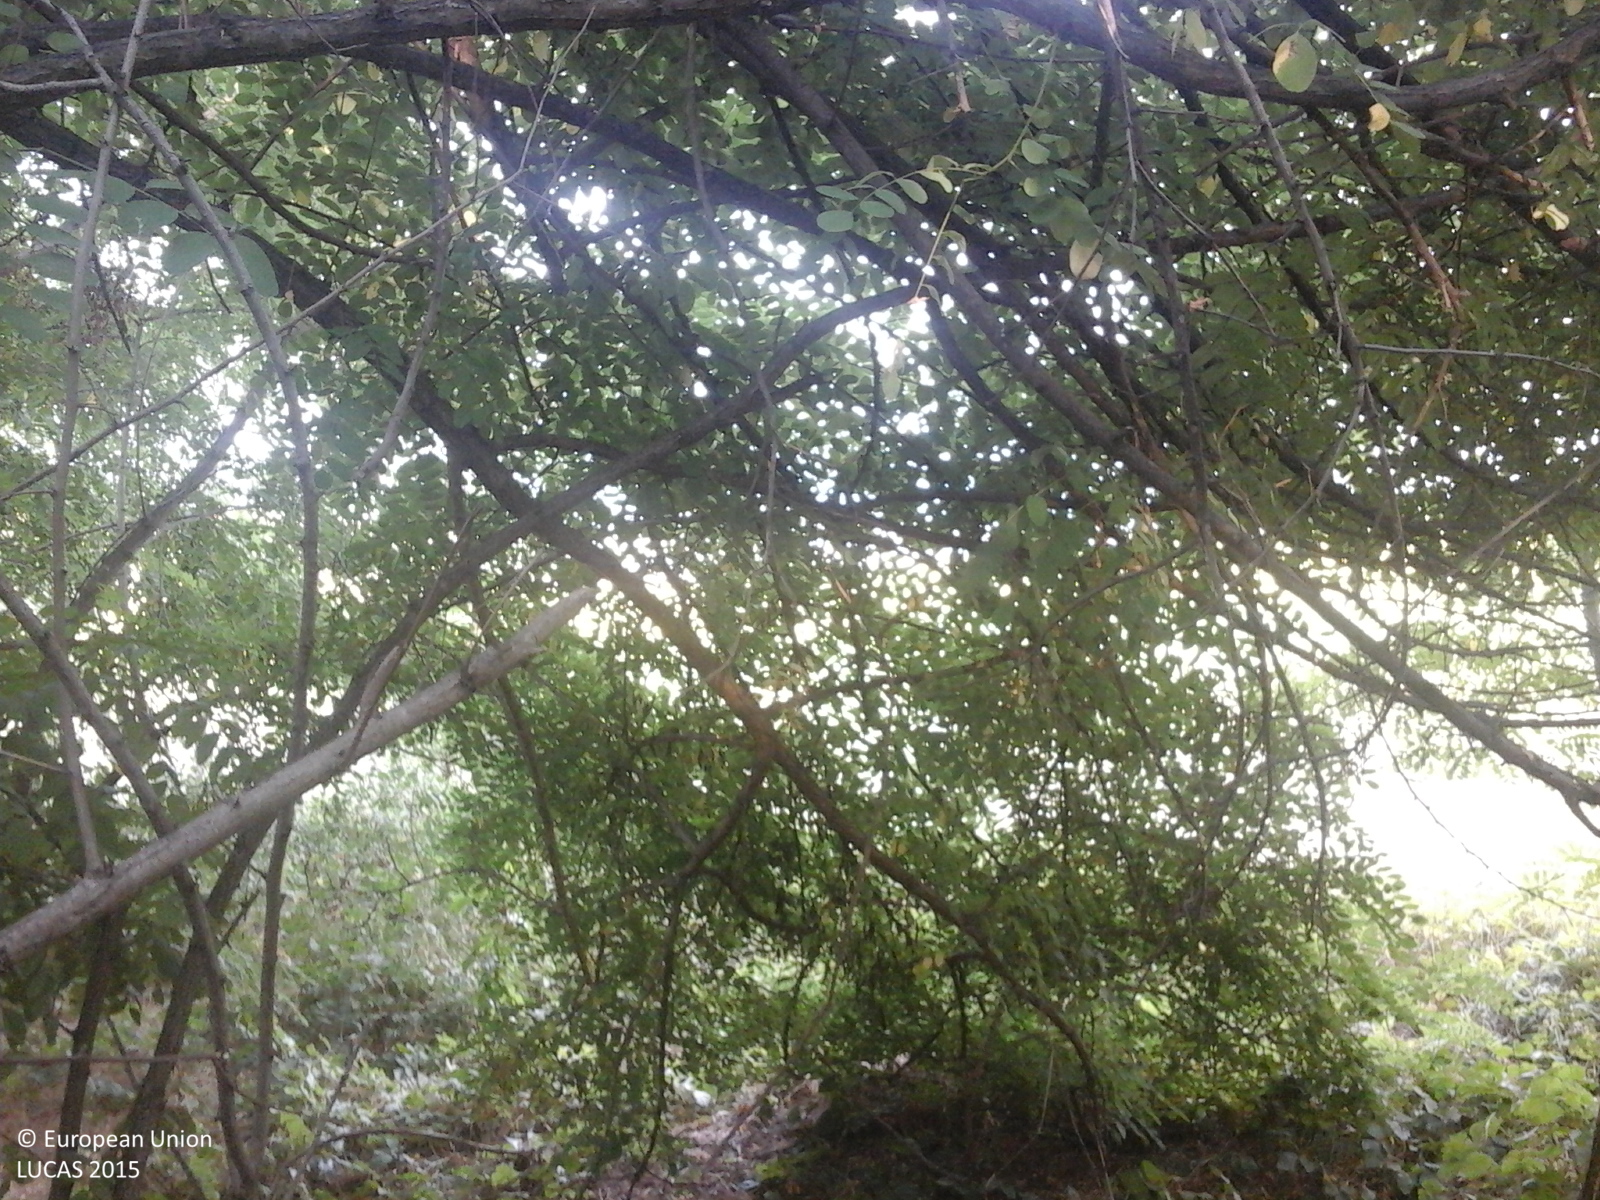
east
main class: Woodland
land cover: Broadleaved woodland
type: exotic forest
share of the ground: > 75 %
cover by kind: broadleaved forest trees 100 %
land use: Forestry
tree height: > 5 m
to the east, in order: Broadleaved woodland; Tracks; Sunflower
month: July
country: RO
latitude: 45.1296
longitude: 28.3714
